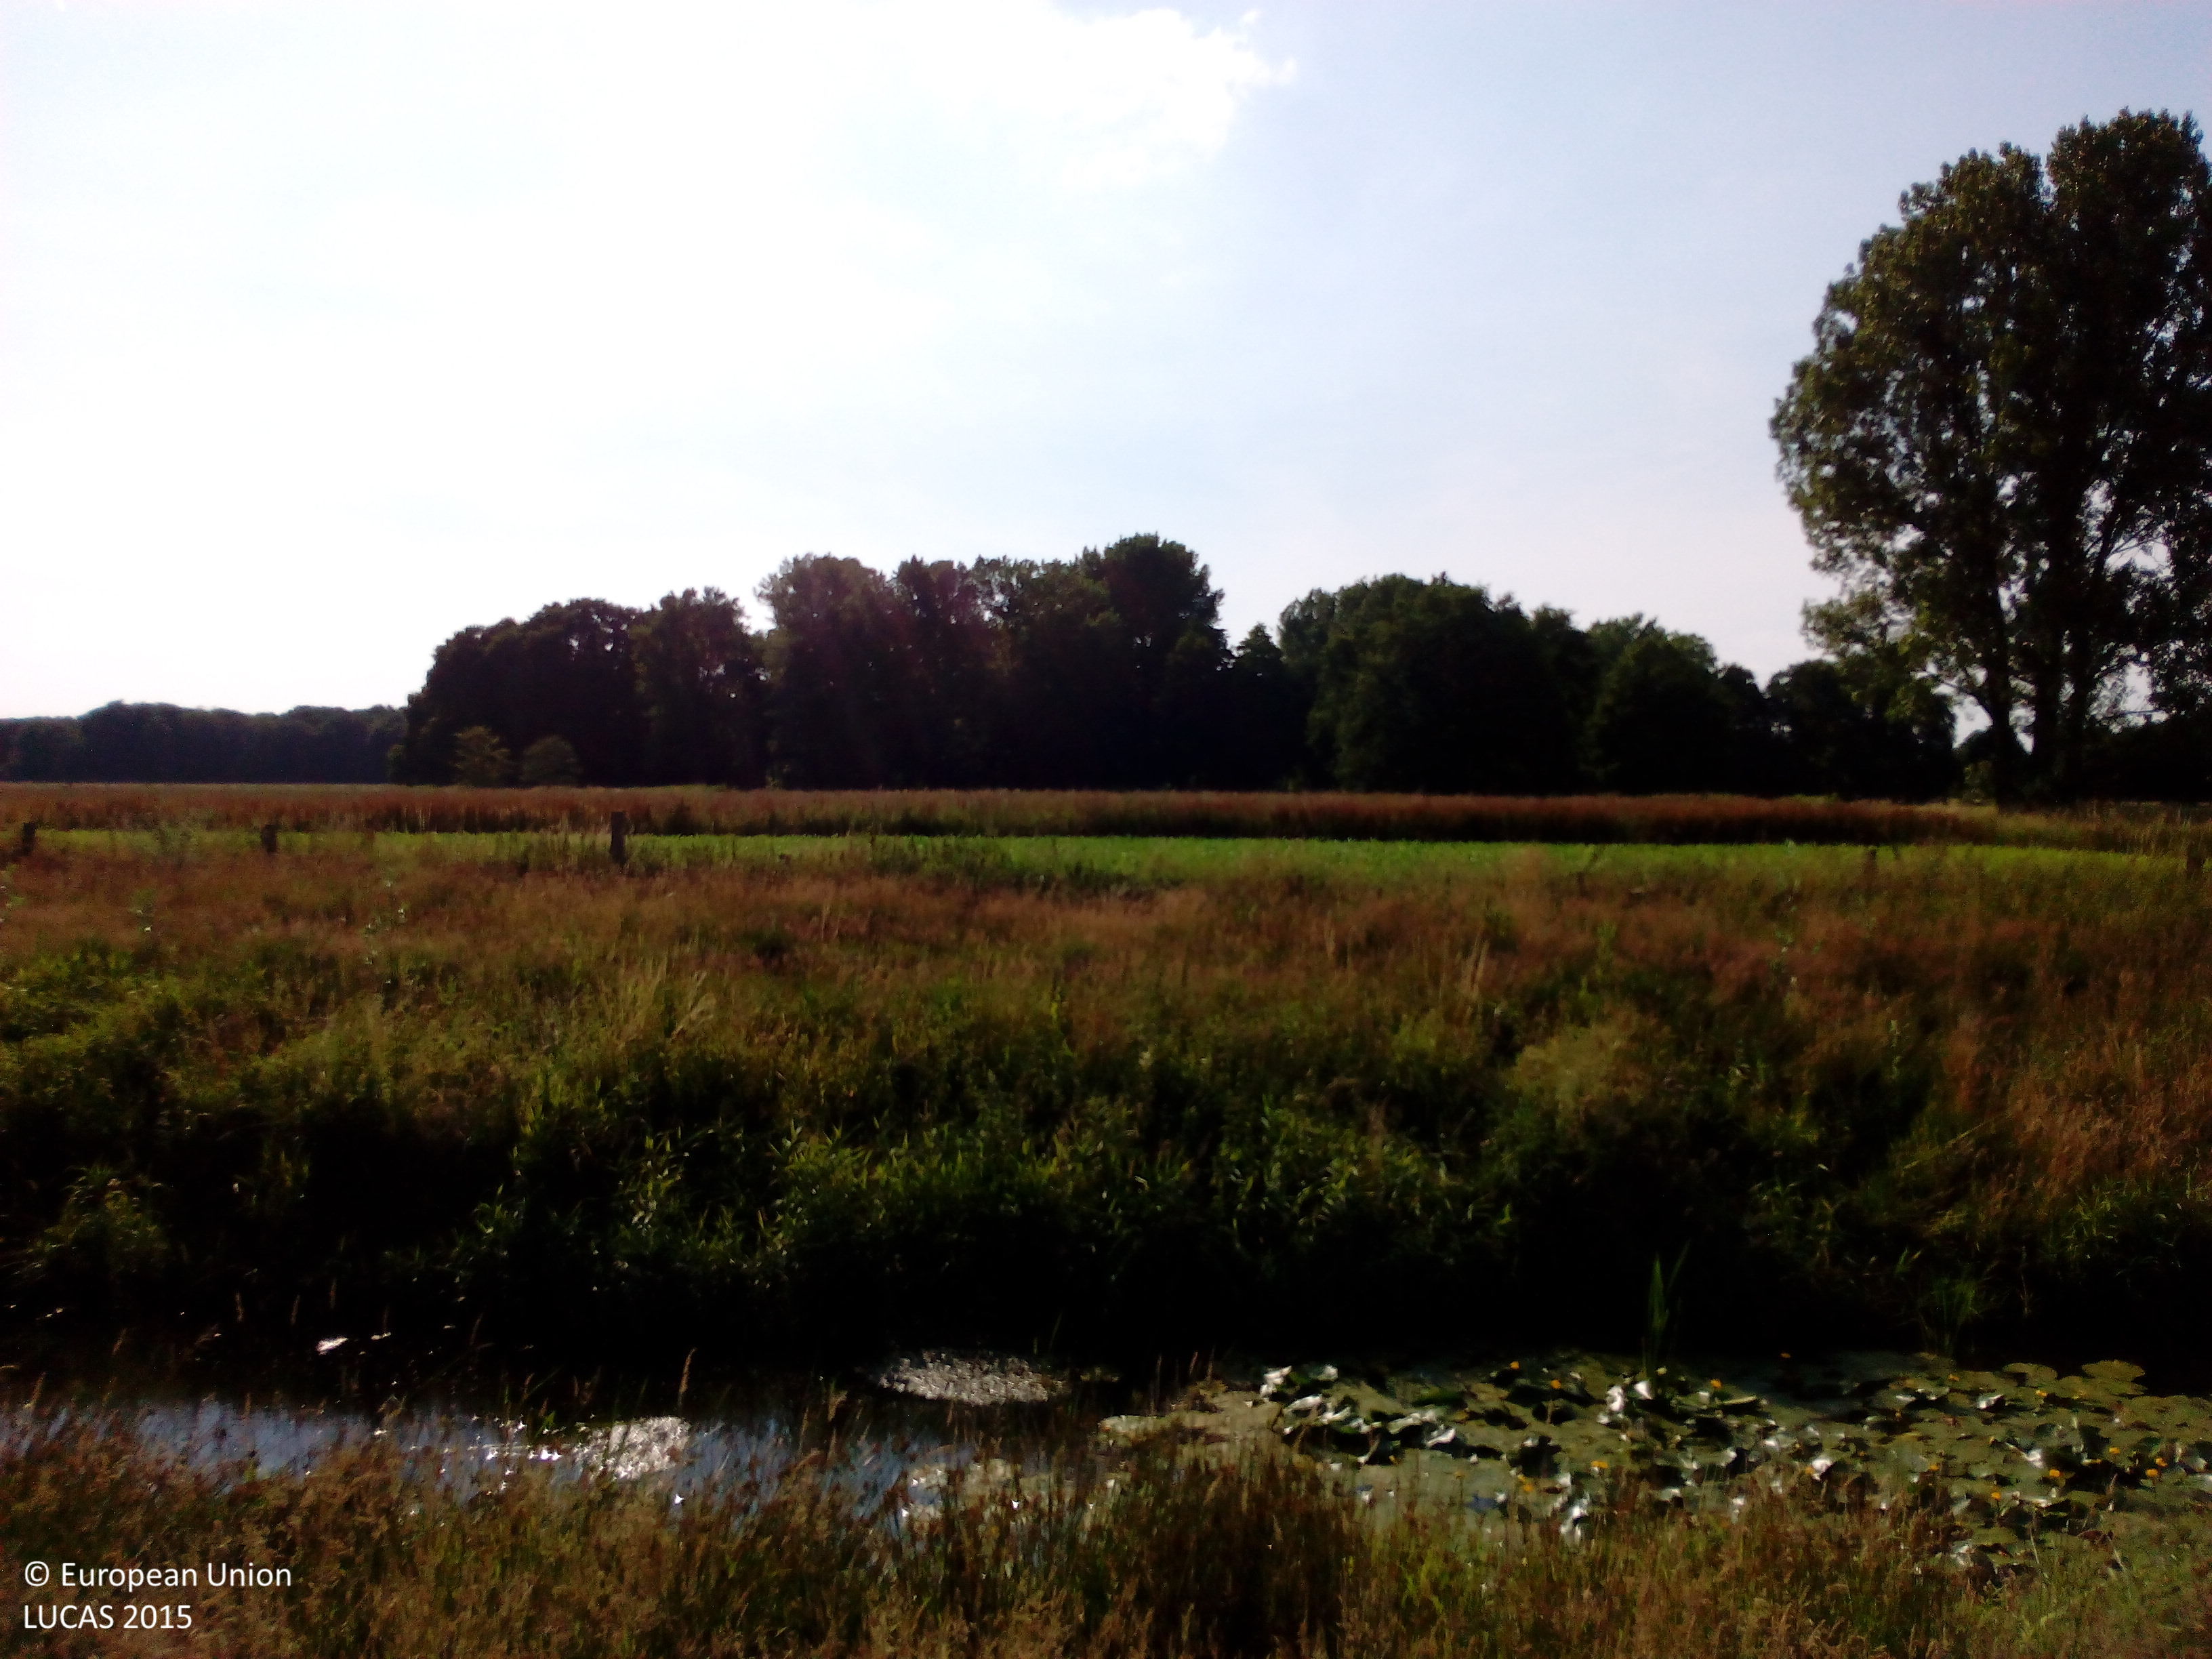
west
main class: Grassland
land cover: Spontaneously vegetated surfaces
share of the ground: > 75 %
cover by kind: herbaceous plants 100 %
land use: Agriculture (excluding fallow land and kitchen gardens)
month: July
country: DE
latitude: 52.5042
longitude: 7.9822
